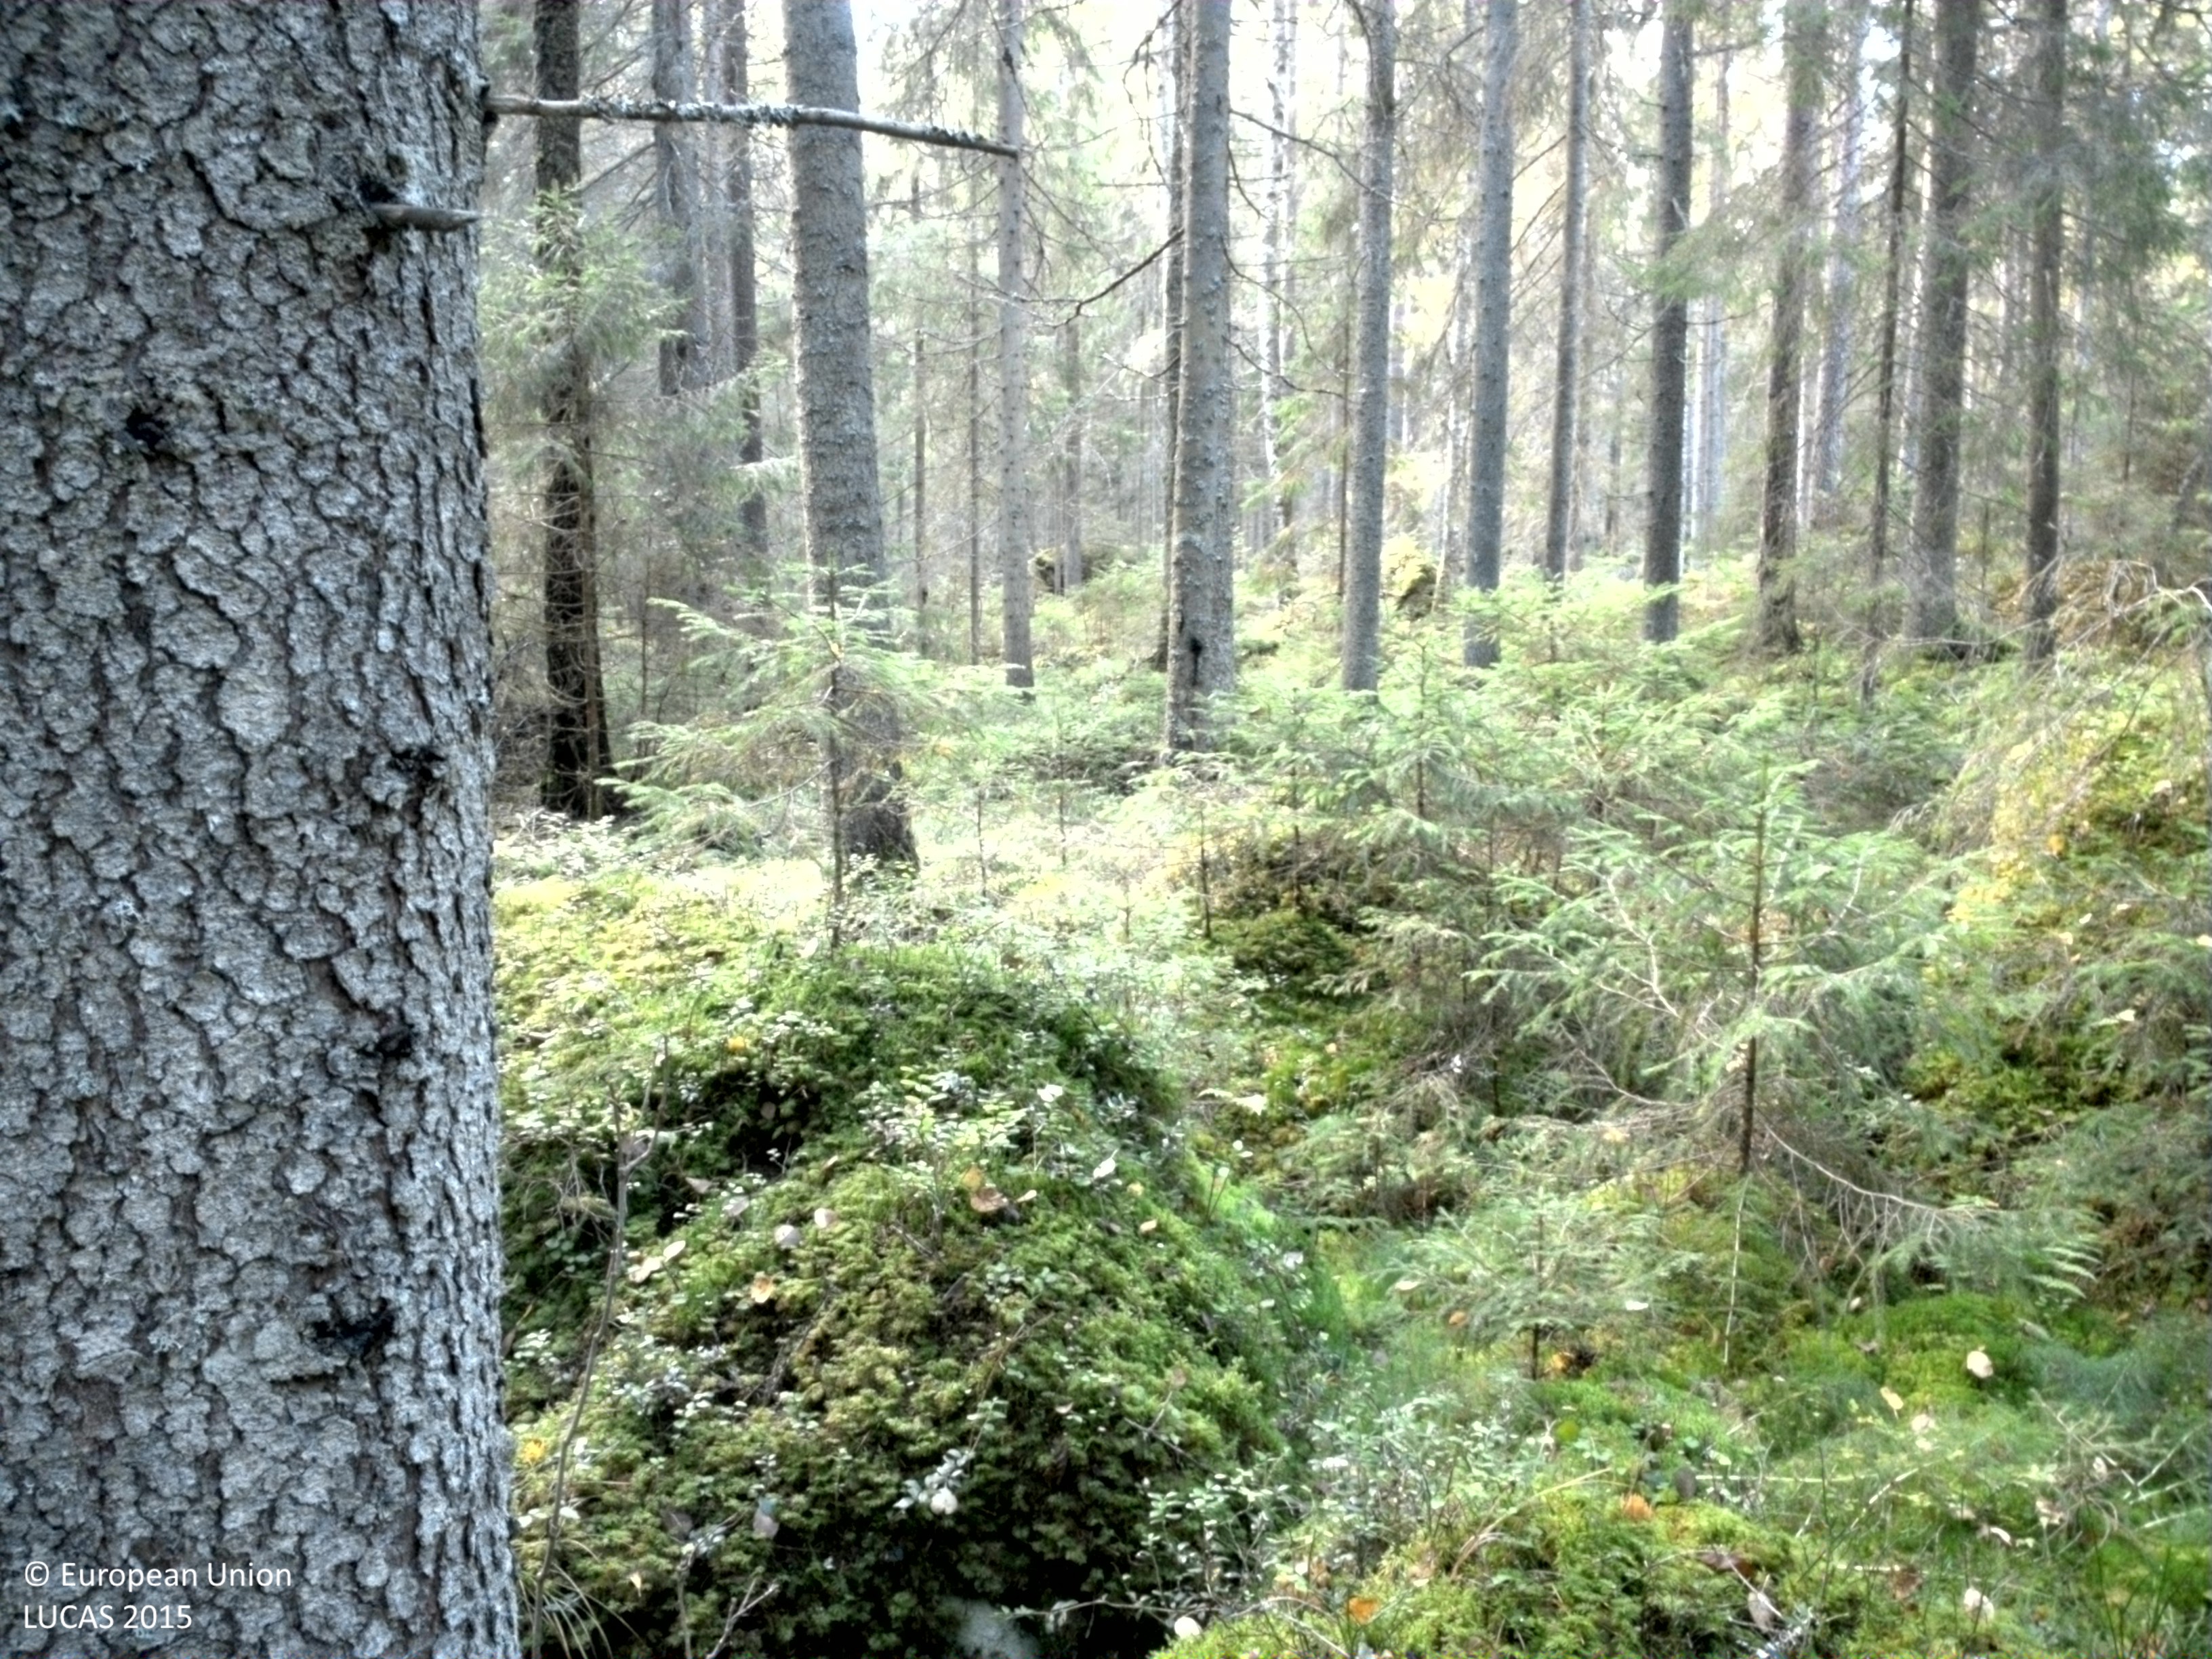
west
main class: Woodland
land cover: Spruce dominated mixed woodland
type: boreal forest
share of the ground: 50 - 75 %
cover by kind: coniferous forest trees 45 %, lichens and mosses 30 %, broadleaved forest trees 15 %, herbaceous plants 10 %
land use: Forestry
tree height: > 5 m
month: September
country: SE
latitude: 60.1347
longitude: 16.5975
